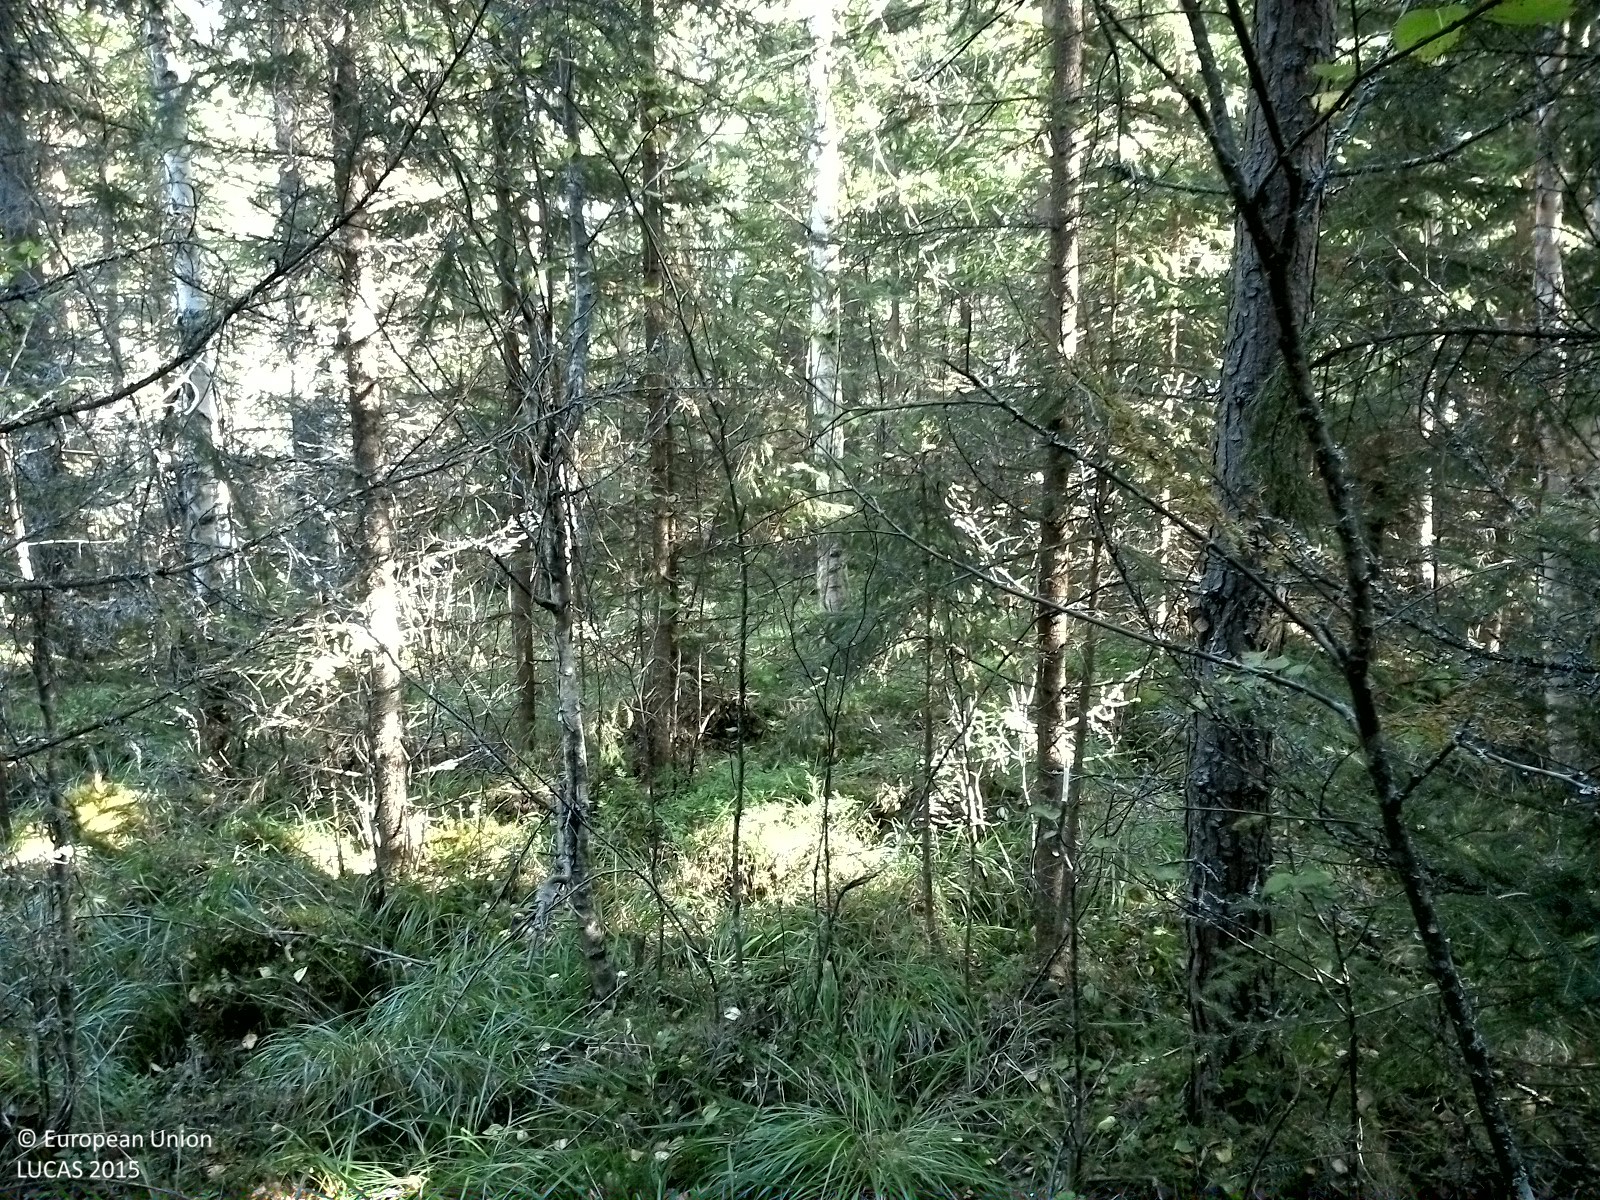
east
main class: Woodland
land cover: Spruce dominated mixed woodland
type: boreal forest
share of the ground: > 75 %
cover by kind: coniferous forest trees 45 %, broadleaved forest trees 25 %, herbaceous plants 15 %, lichens and mosses 15 %
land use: Forestry
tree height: > 5 m
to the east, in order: Spruce dominated mixed woodland; Other mixed woodland; Pine dominated mixed woodland; Ditches and canals; Tracks; Ditches and canals; Other coniferous woodland; Spruce dominated coniferous woodland
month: September
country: SE
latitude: 62.5334
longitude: 16.3340
